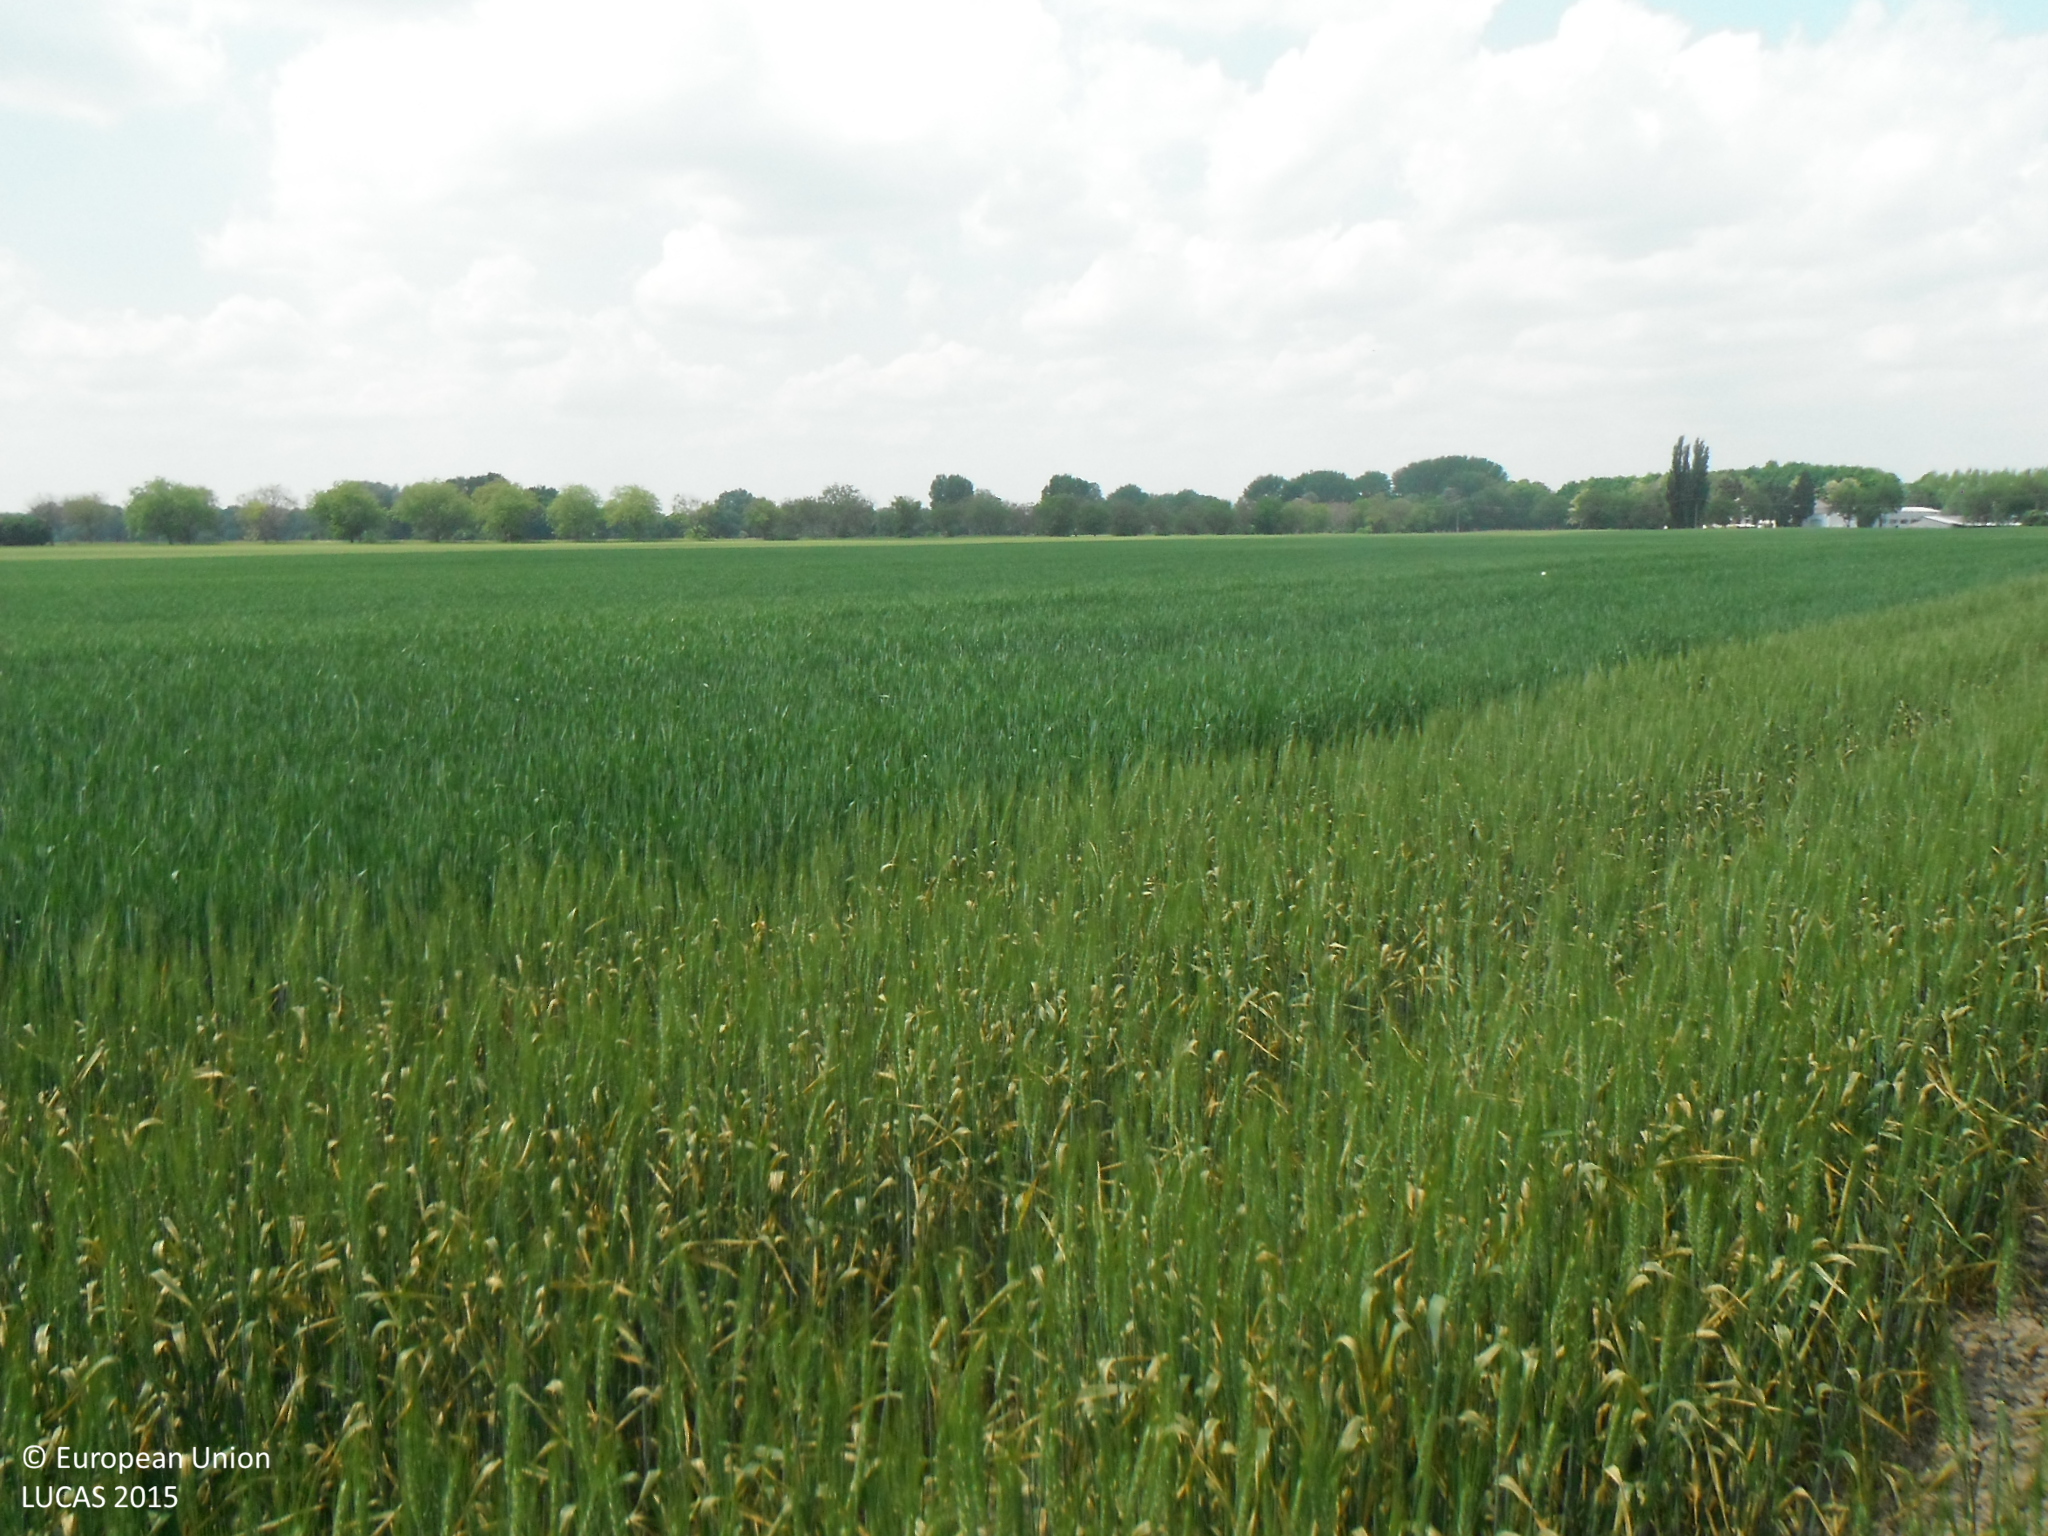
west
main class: Cropland
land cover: Common wheat
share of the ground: > 75 %
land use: Agriculture (excluding fallow land and kitchen gardens)
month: May
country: SK
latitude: 48.0230
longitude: 17.7476
